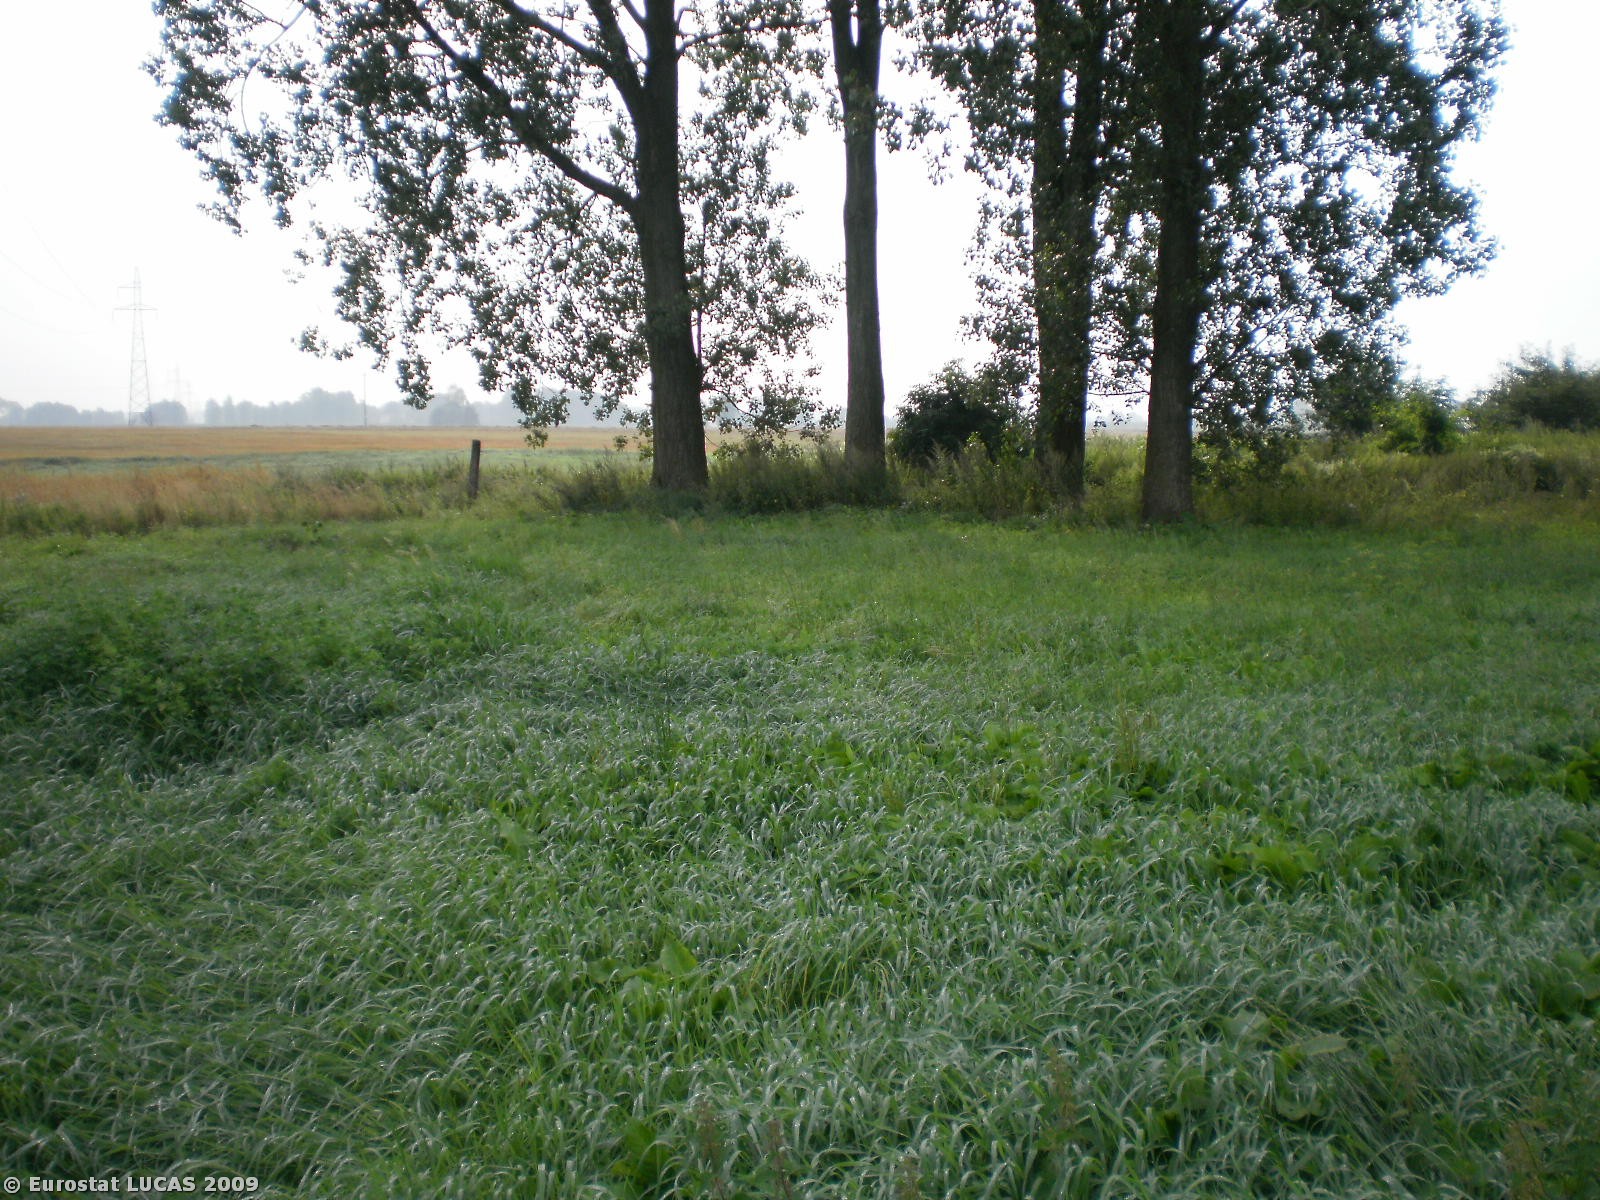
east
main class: Grassland
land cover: Grassland without tree/shrub cover
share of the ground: > 75 %
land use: Agriculture (excluding fallow land and kitchen gardens)
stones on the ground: < 10 %
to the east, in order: Grassland without tree/shrub cover; Lines of trees; Spontaneously vegetated surfaces; Ditches and canals; Grassland without tree/shrub cover; Triticale; Grass margins; Rye
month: August
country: PL
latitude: 53.0341
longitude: 20.9138
